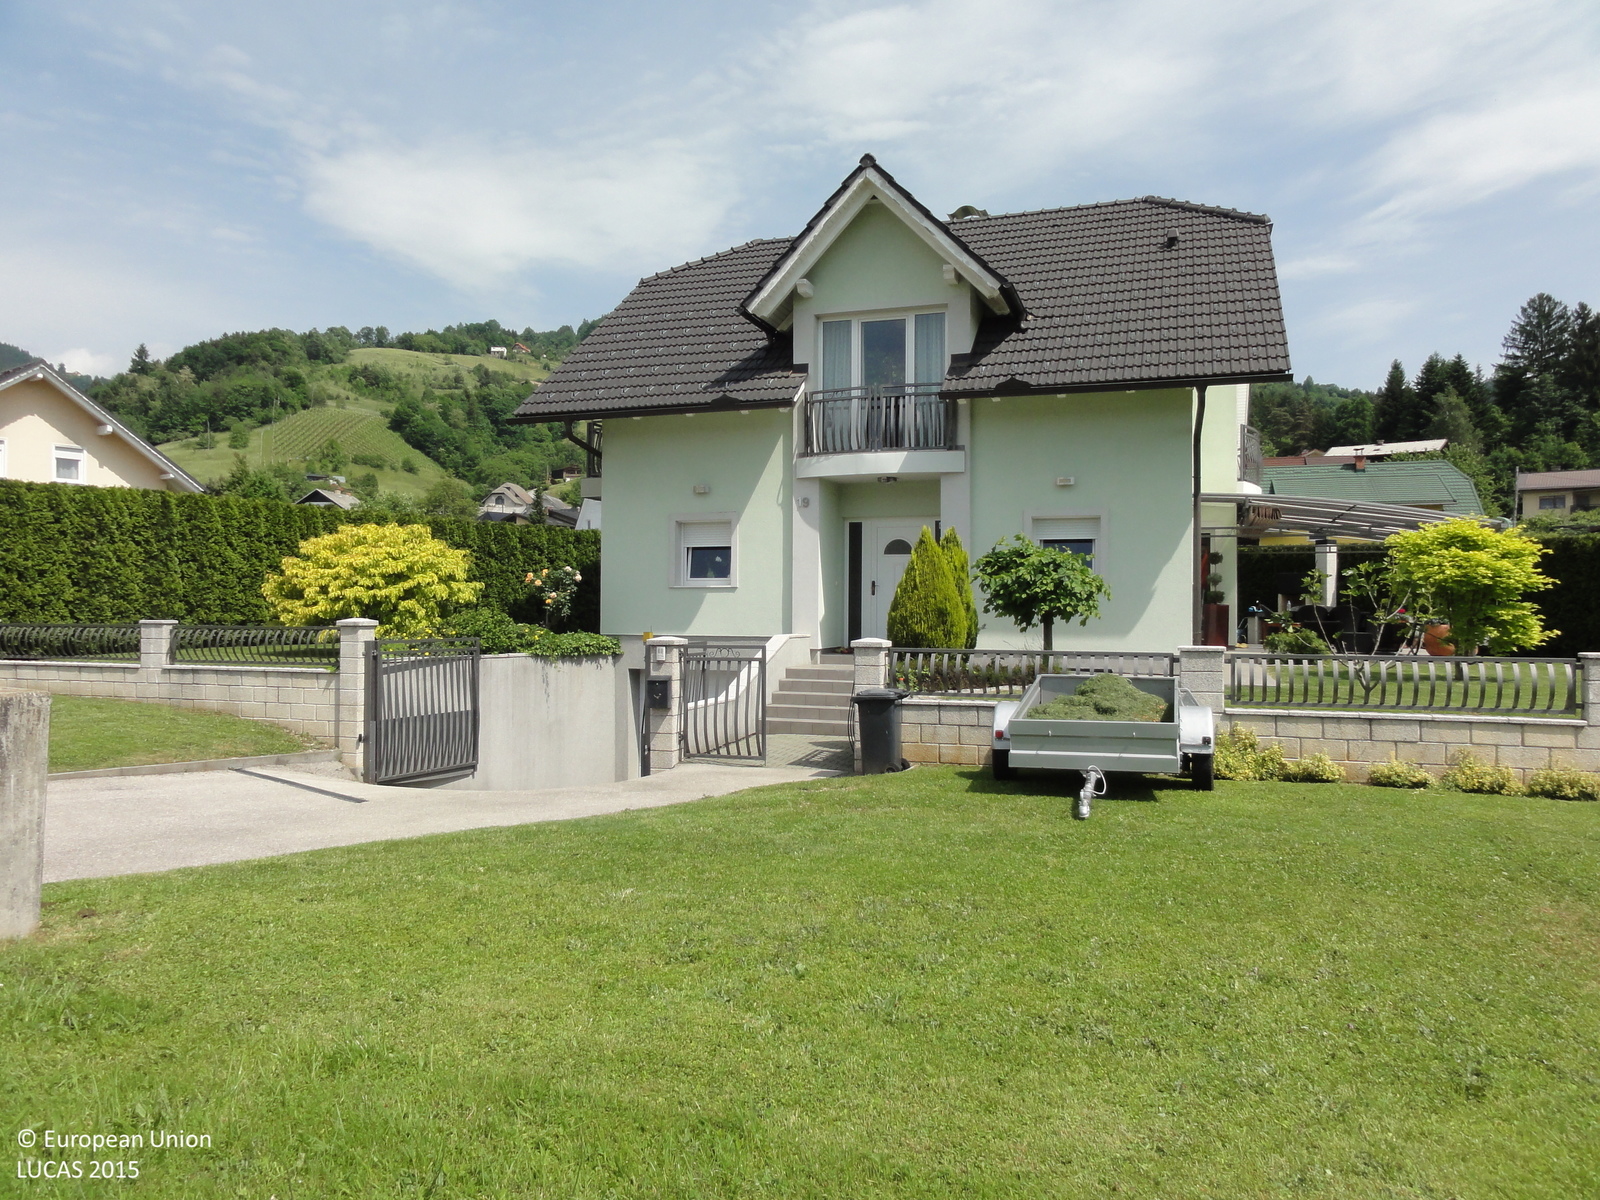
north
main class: Grassland
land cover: Grassland without tree/shrub cover
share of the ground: > 75 %
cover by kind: herbaceous plants 100 %
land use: Agriculture (excluding fallow land and kitchen gardens)
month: May
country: SI
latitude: 46.5532
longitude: 15.4899
